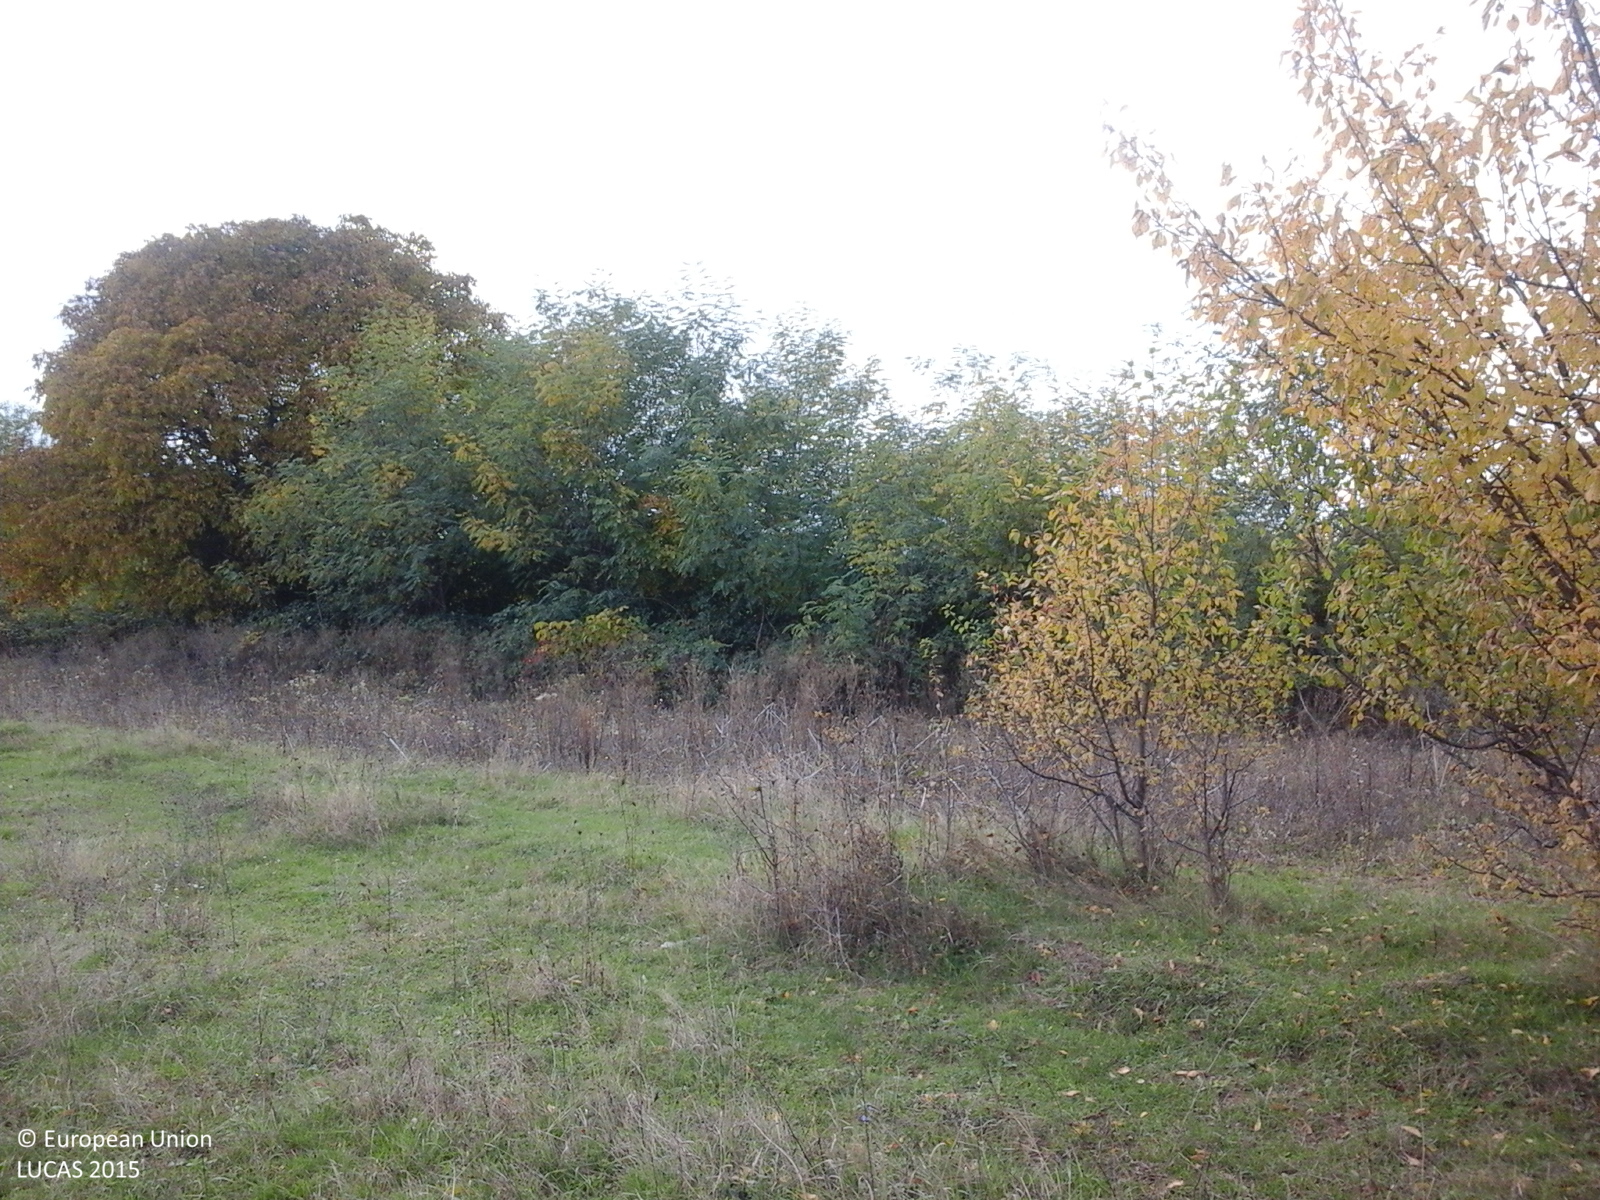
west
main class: Grassland
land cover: Grassland without tree/shrub cover
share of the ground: > 75 %
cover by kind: herbaceous plants 100 %
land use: Agriculture (excluding fallow land and kitchen gardens)
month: October
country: RO
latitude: 45.0946
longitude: 25.7971
